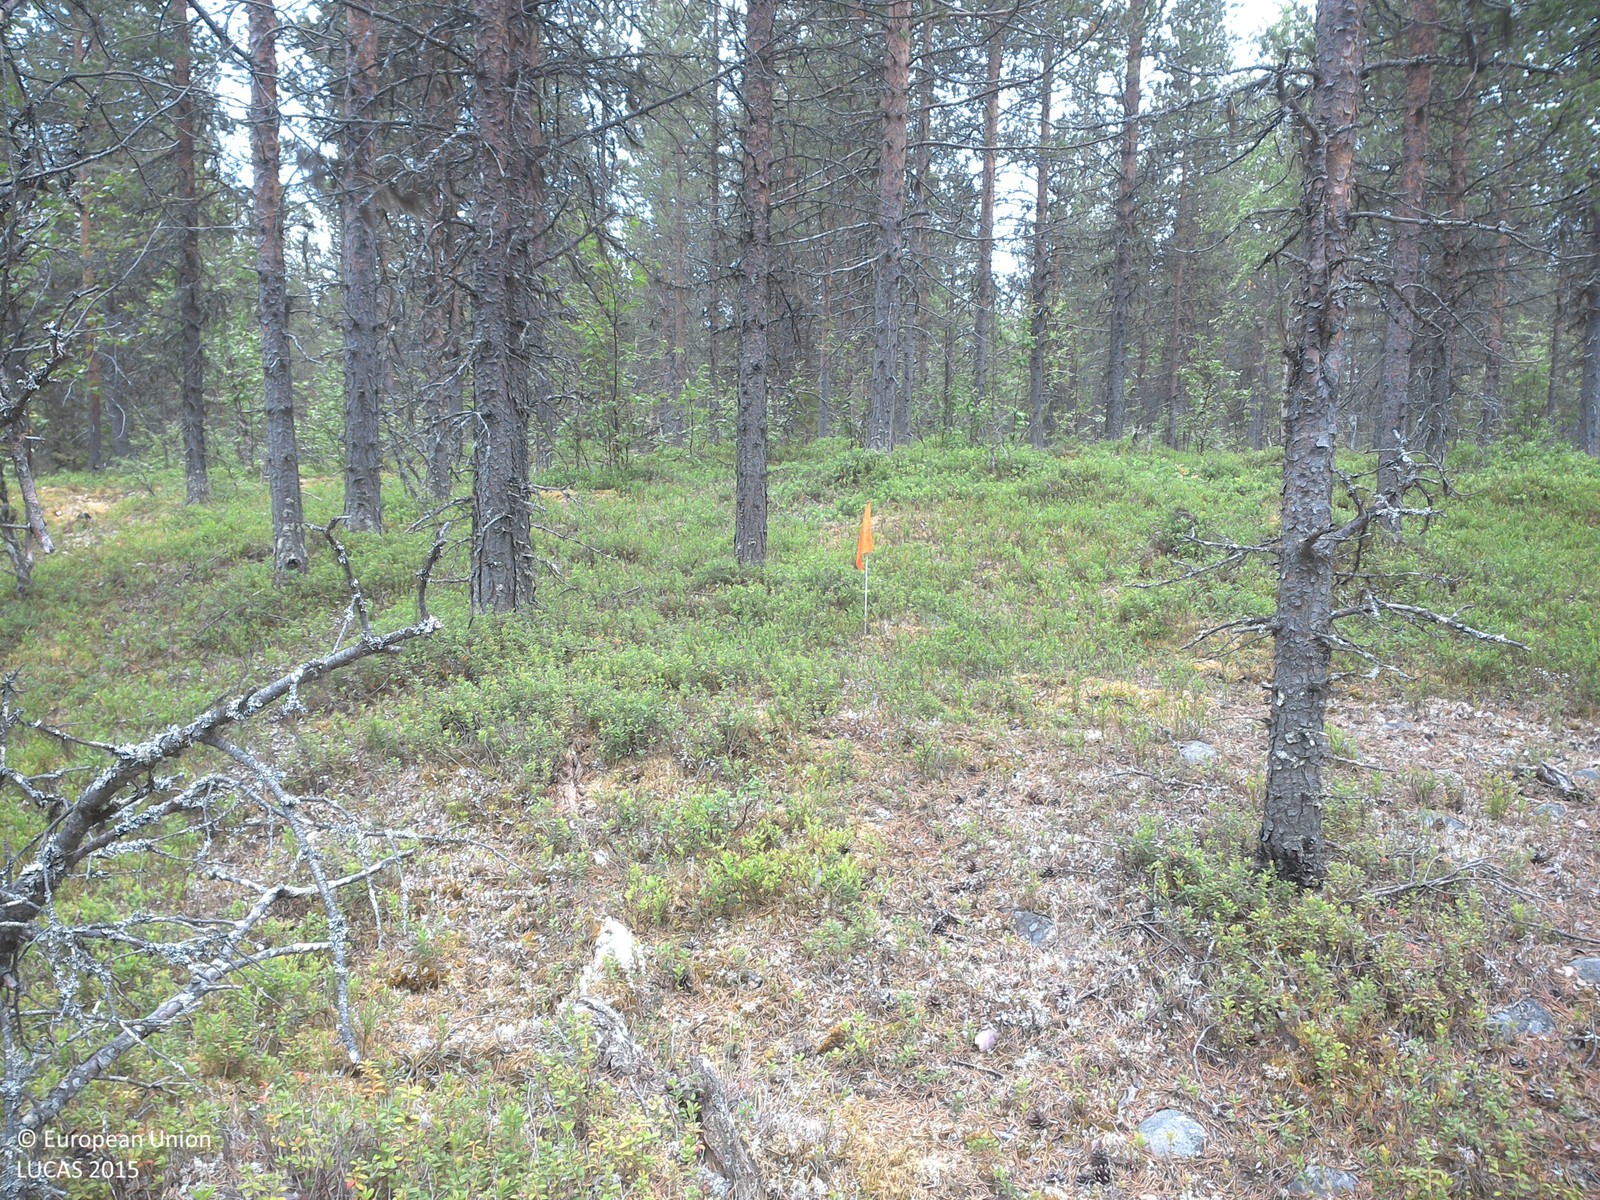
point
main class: Woodland
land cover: Pine dominated coniferous woodland
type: boreal forest
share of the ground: 25 - 50 %
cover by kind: shrubs 55 %, coniferous forest trees 30 %, lichens and mosses 10 %, broadleaved forest trees 5 %
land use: Forestry
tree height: > 5 m
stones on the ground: 25 - 50 %
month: July
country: SE
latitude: 67.5669
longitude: 22.0936
